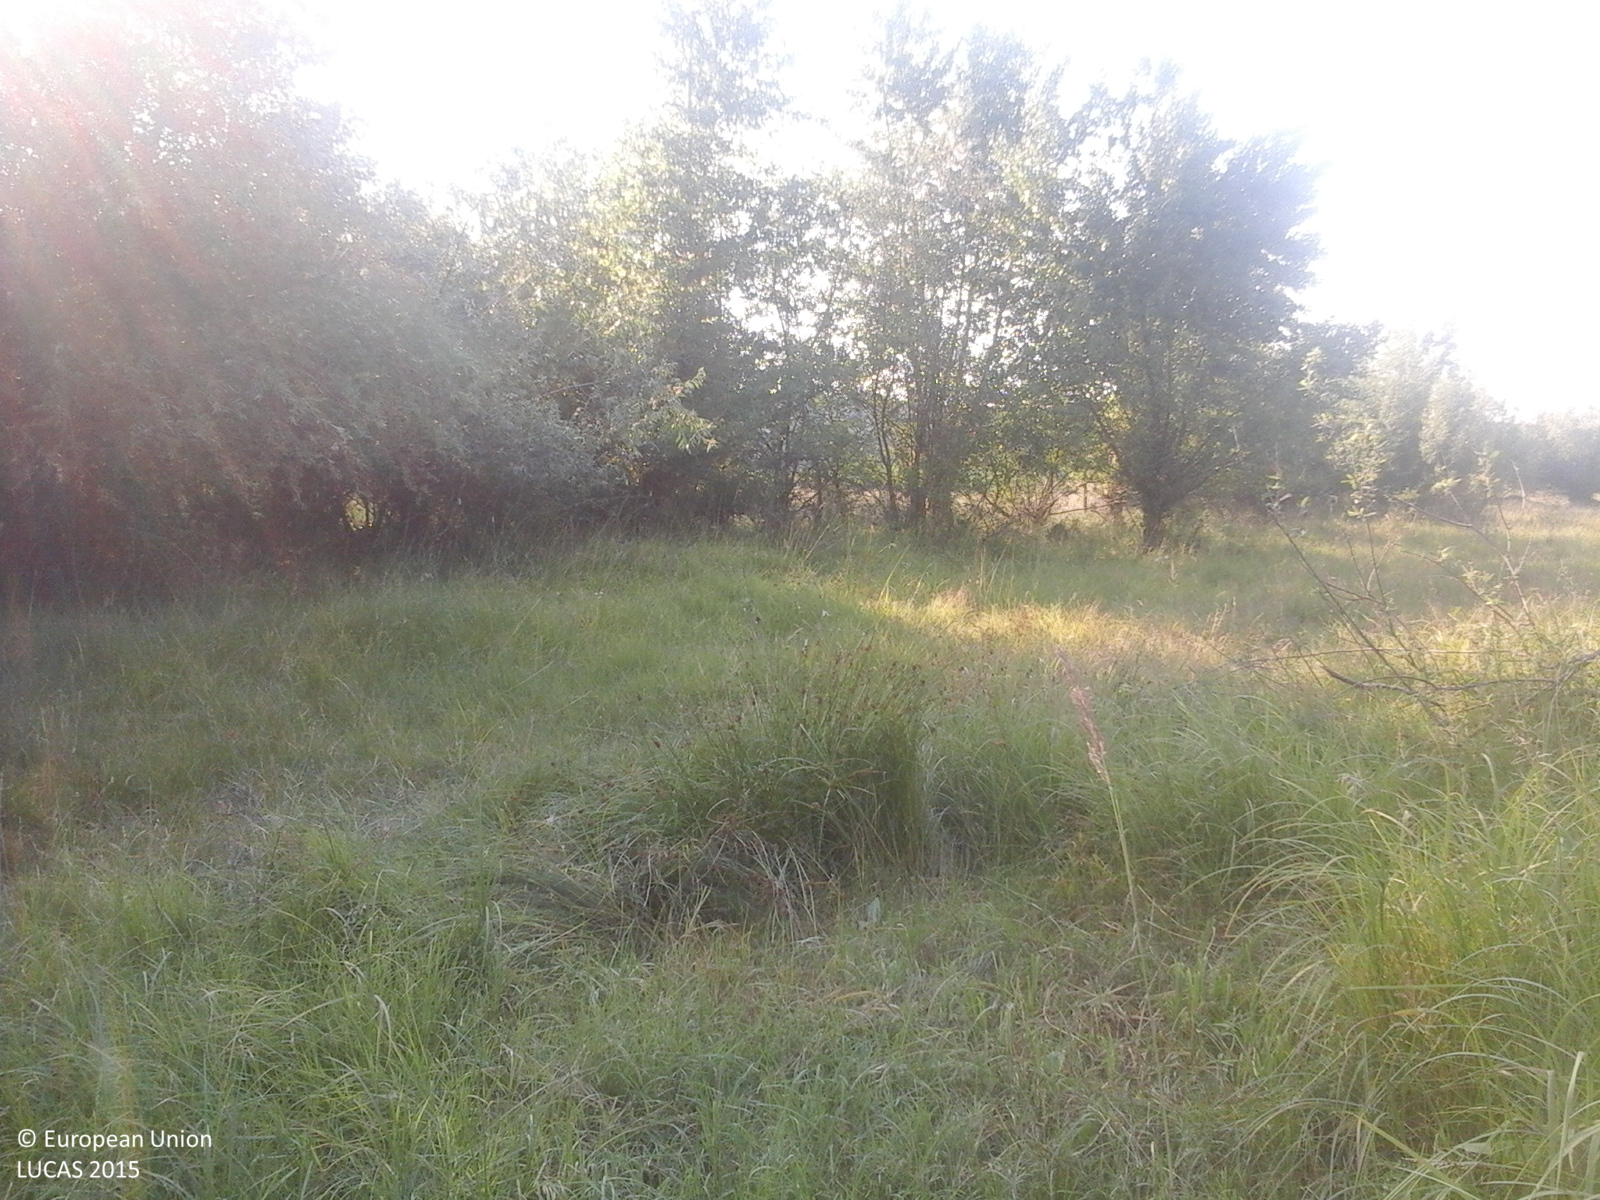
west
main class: Grassland
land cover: Grassland with sparse tree/shrub cover
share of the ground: > 75 %
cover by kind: herbaceous plants 85 %, shrubs 10 %, broadleaved forest trees 5 %
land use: Semi-natural and natural areas not in use
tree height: > 5 m
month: July
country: RO
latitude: 44.5224
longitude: 24.7080
